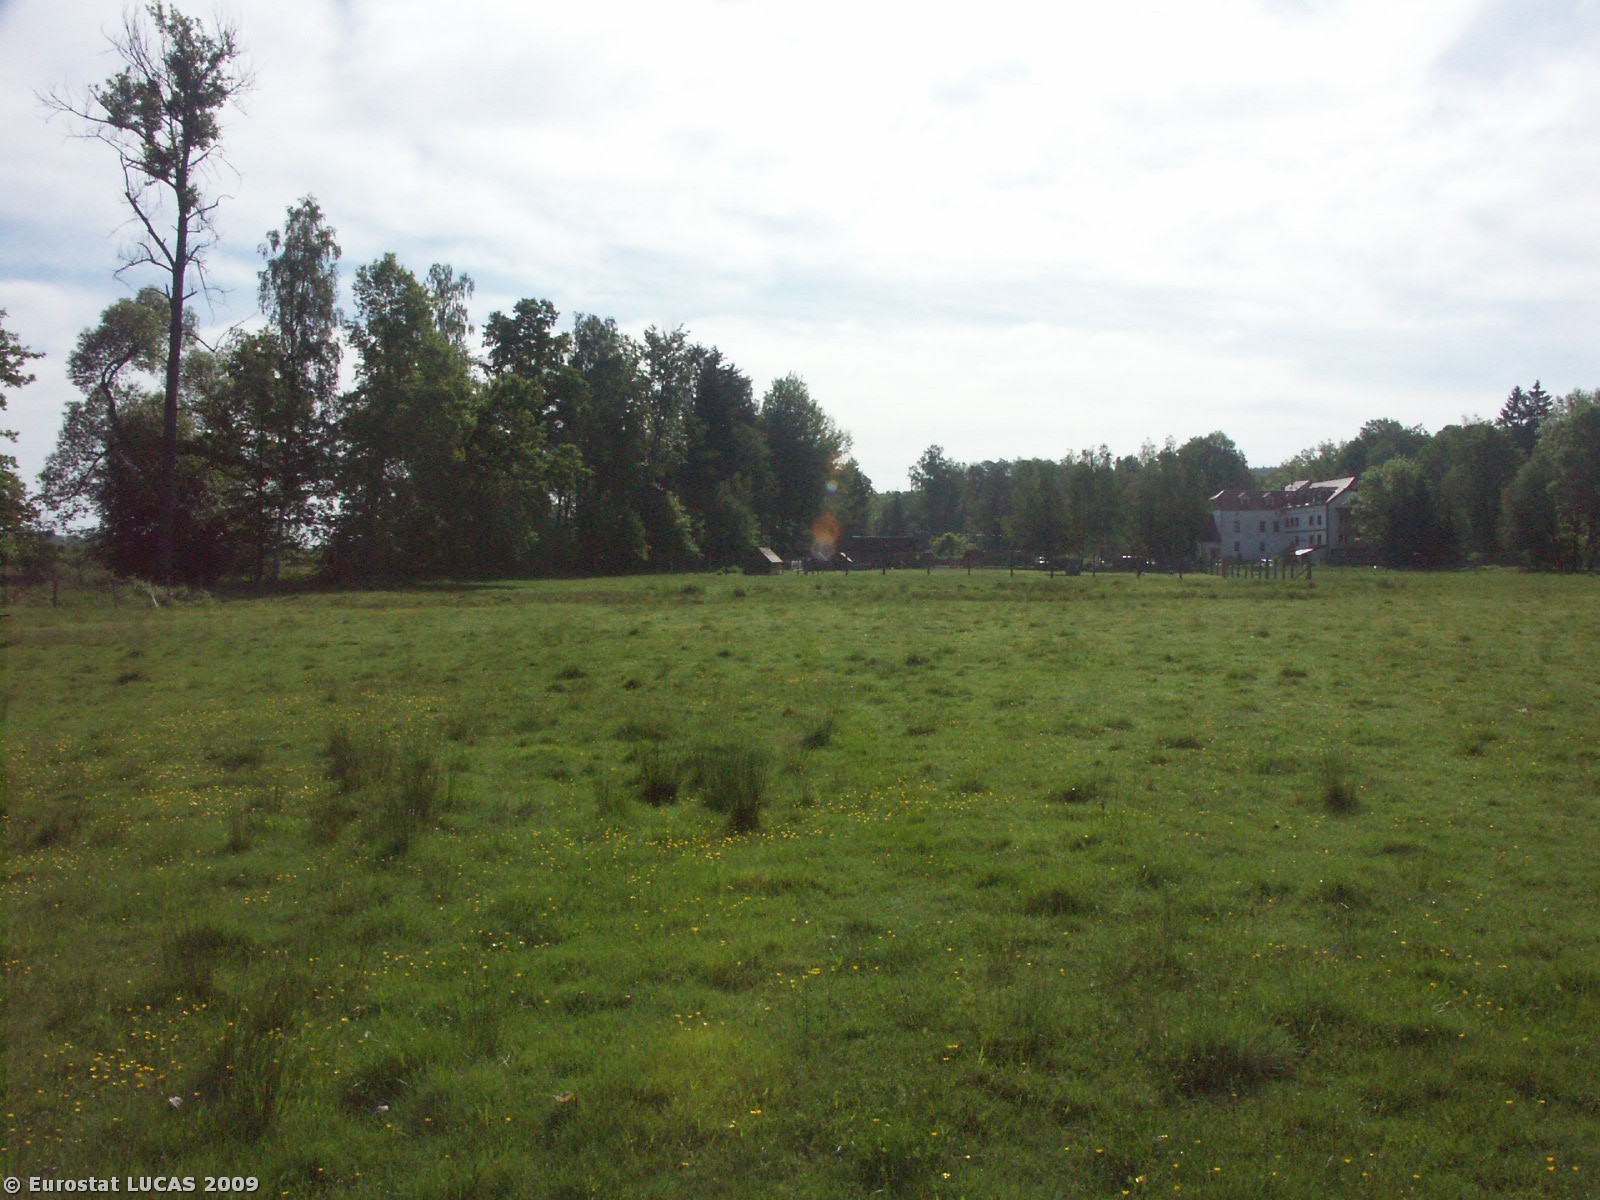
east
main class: Grassland
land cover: Grassland without tree/shrub cover
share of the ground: > 75 %
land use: Agriculture (excluding fallow land and kitchen gardens)
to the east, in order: Grassland without tree/shrub cover; Fences; Grassland without tree/shrub cover; Artificial constructions in urban areas; Fences; Mixed woodland; Tracks; Mixed woodland; Paved roads, cycling and walking lanes; Broadleaved woodland
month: May
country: CZ
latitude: 48.8835
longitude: 14.6242
